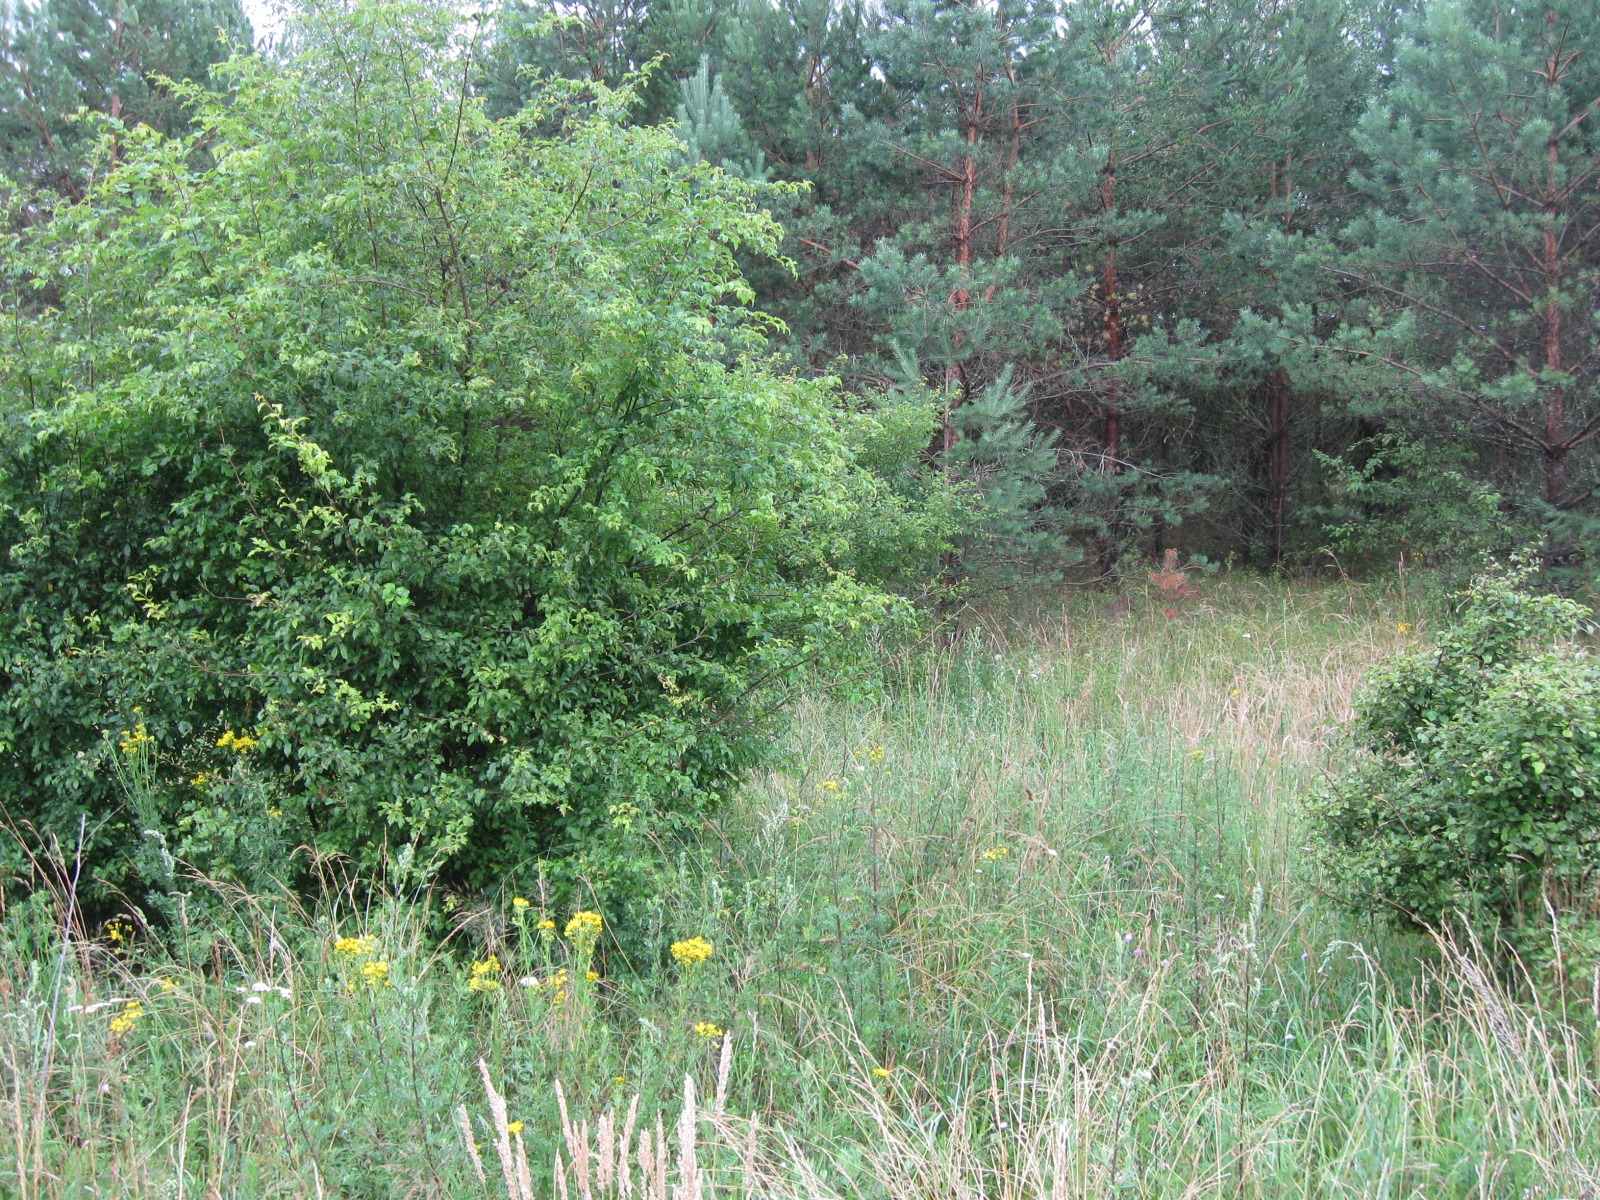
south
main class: Grassland
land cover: Grassland with sparse tree/shrub cover
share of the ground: > 75 %
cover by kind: herbaceous plants 90 %, broadleaved forest trees 5 %, shrubs 5 %
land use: Forestry
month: July
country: LT
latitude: 54.0320
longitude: 23.6275
